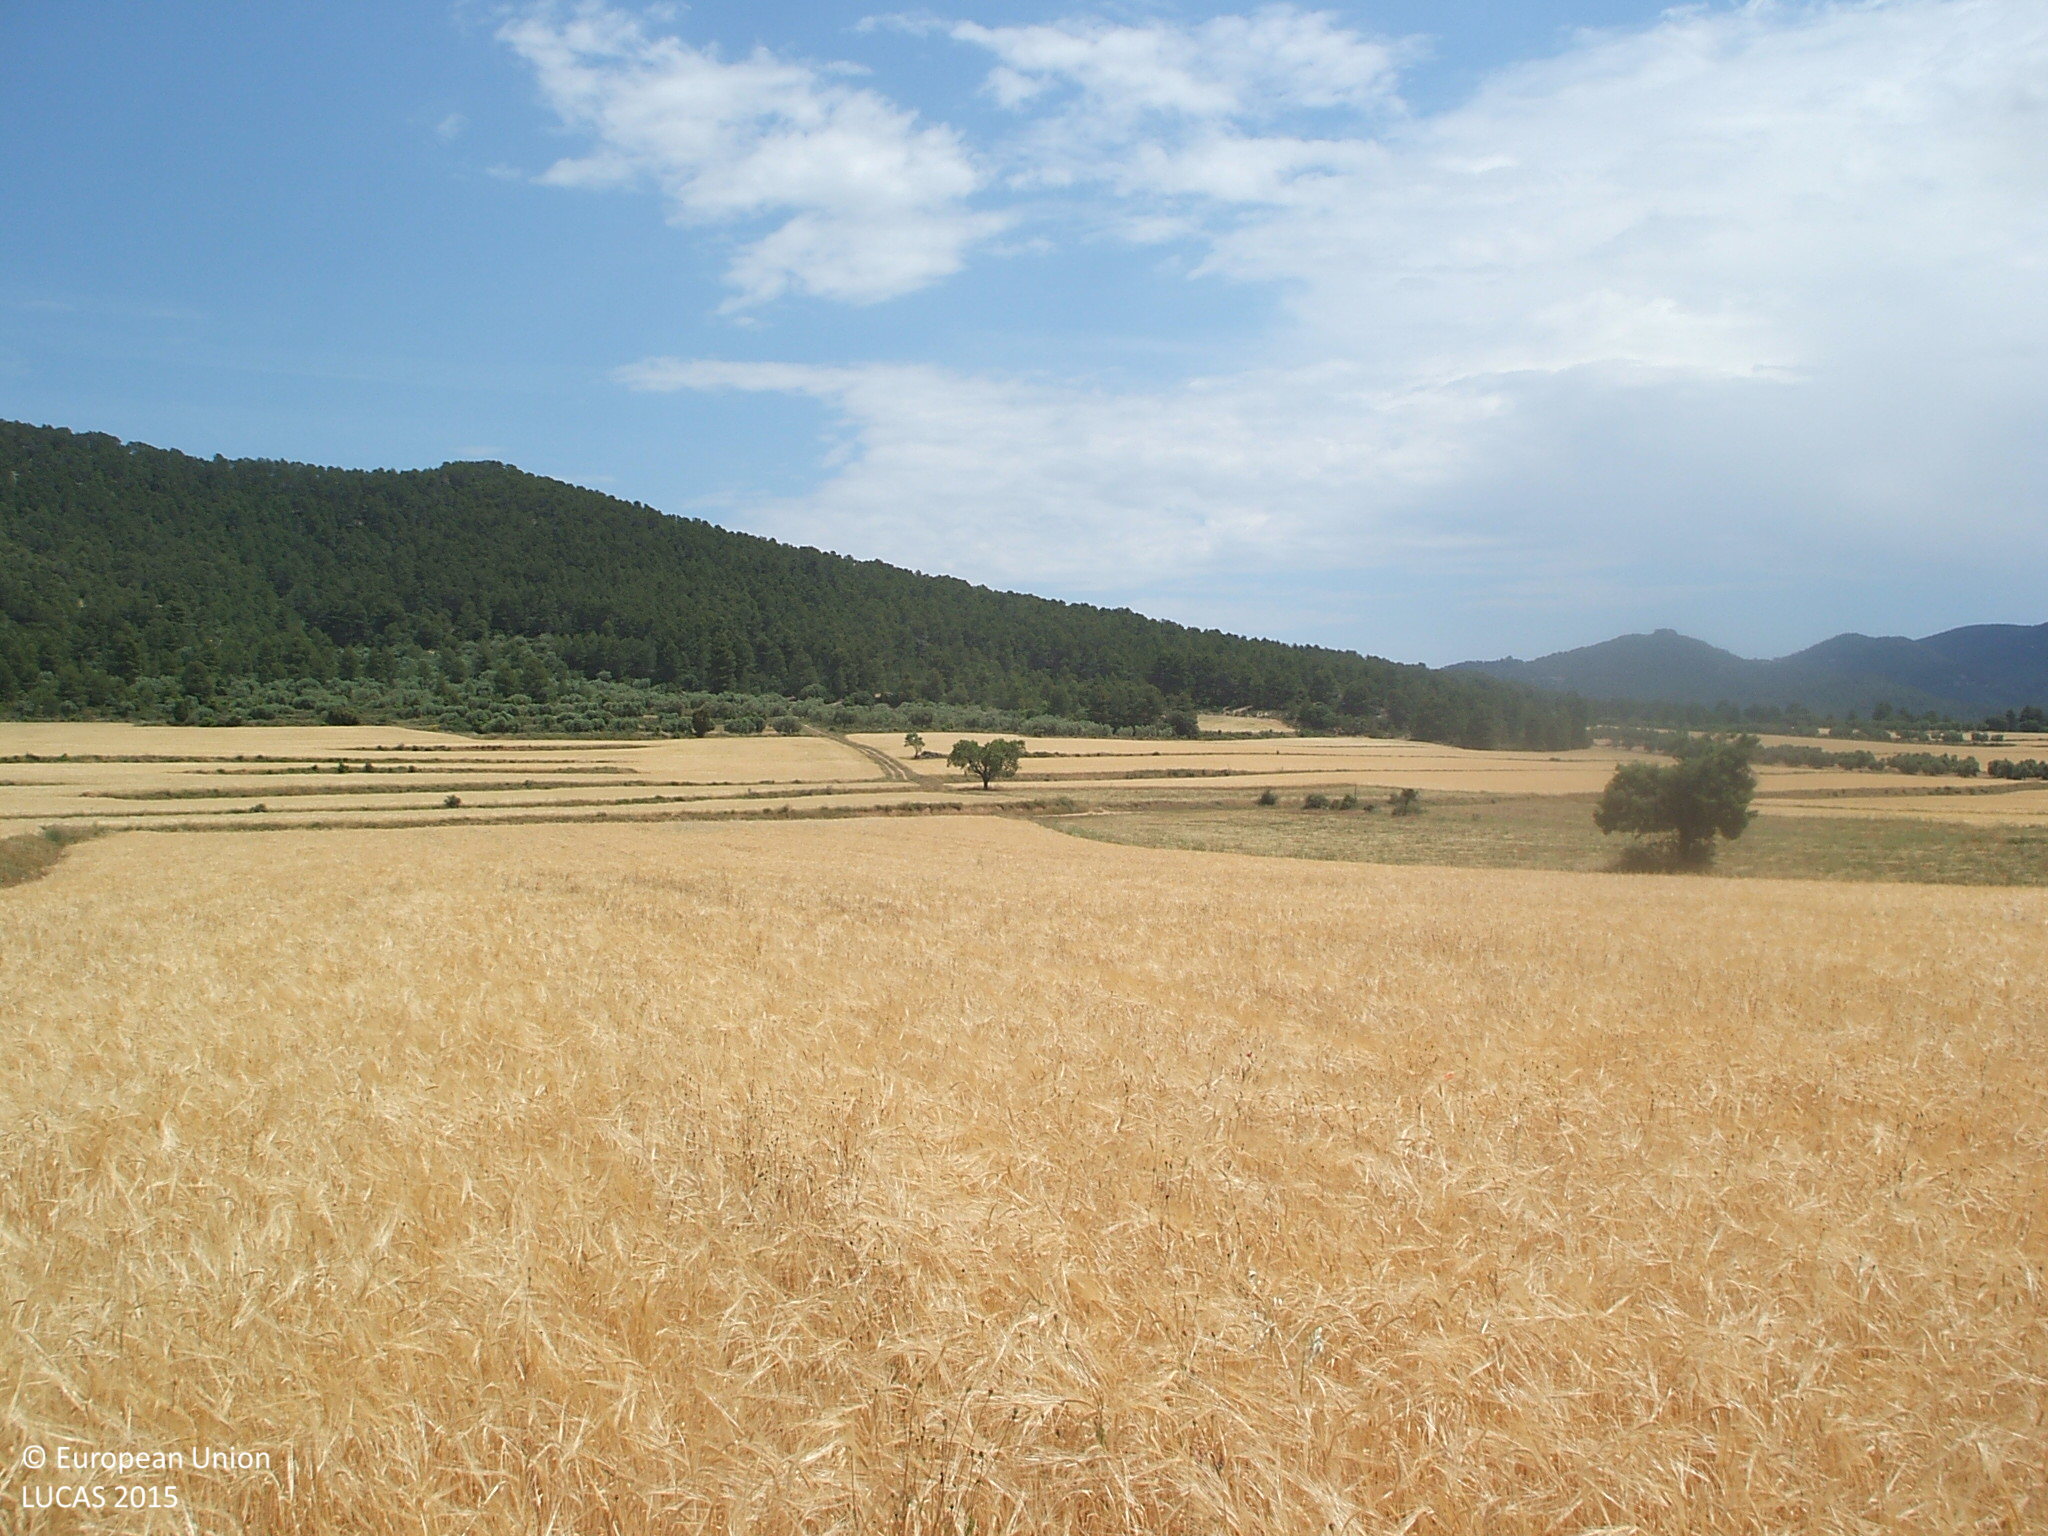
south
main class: Cropland
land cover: Barley
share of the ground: > 75 %
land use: Agriculture (excluding fallow land and kitchen gardens)
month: June
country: ES
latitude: 40.8148
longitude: -0.1457
